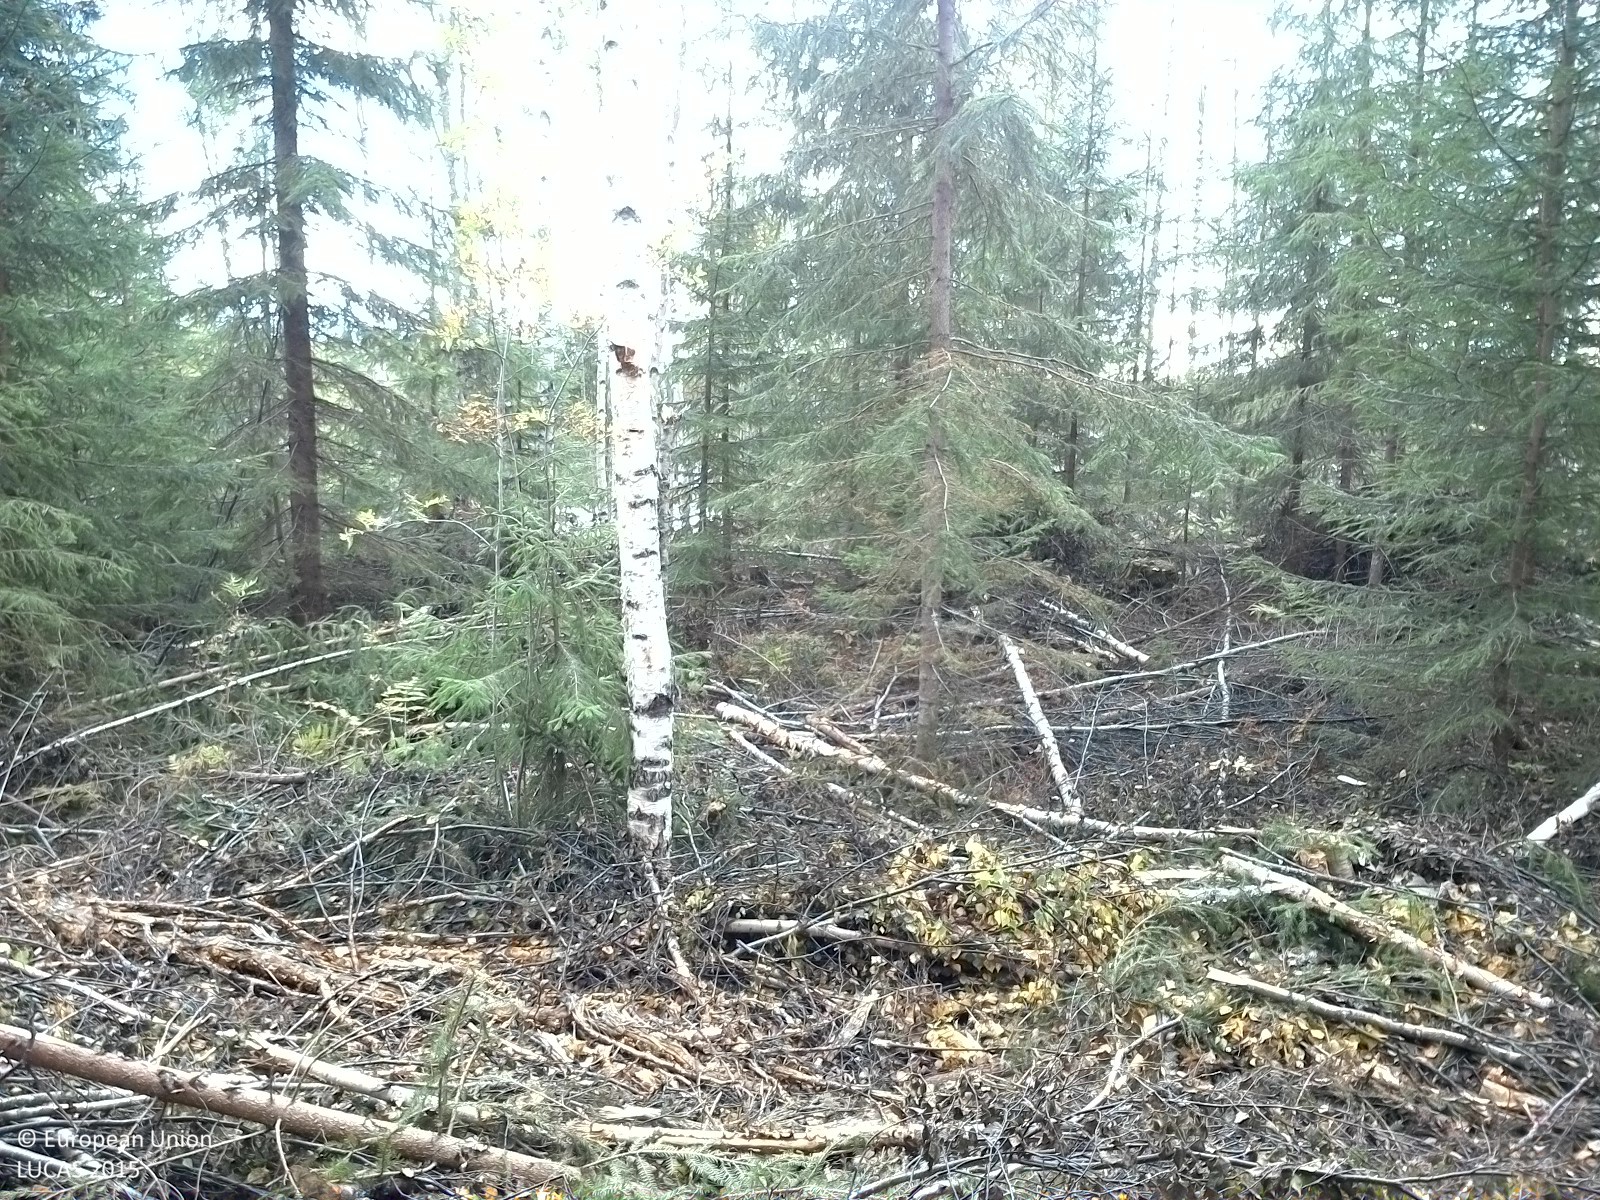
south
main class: Woodland
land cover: Spruce dominated coniferous woodland
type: boreal forest
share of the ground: > 75 %
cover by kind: coniferous forest trees 60 %, broadleaved forest trees 15 %, herbaceous plants 5 %, lichens and mosses 5 %
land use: Forestry
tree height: > 5 m
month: September
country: SE
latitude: 62.3286
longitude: 17.2576
